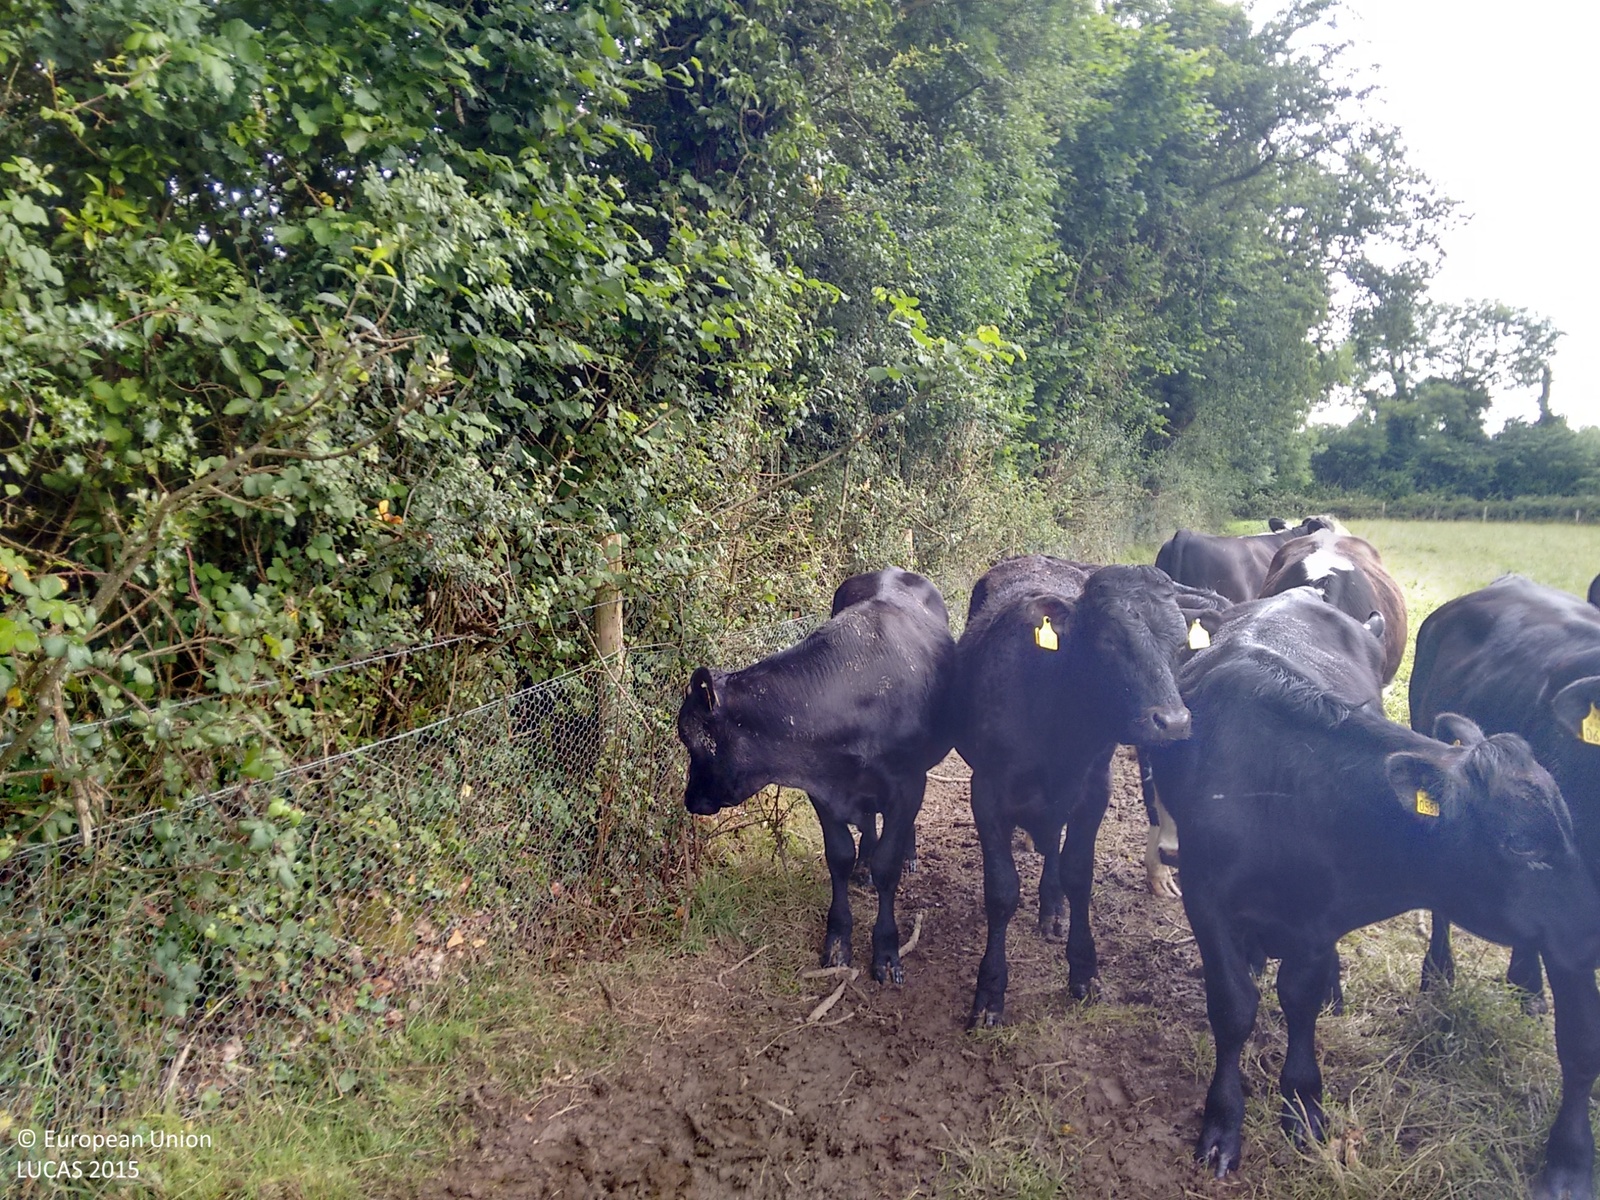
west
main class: Grassland
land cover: Grassland without tree/shrub cover
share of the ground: > 75 %
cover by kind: herbaceous plants 100 %
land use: Agriculture (excluding fallow land and kitchen gardens)
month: July
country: IE
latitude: 52.6171
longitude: -7.4532
